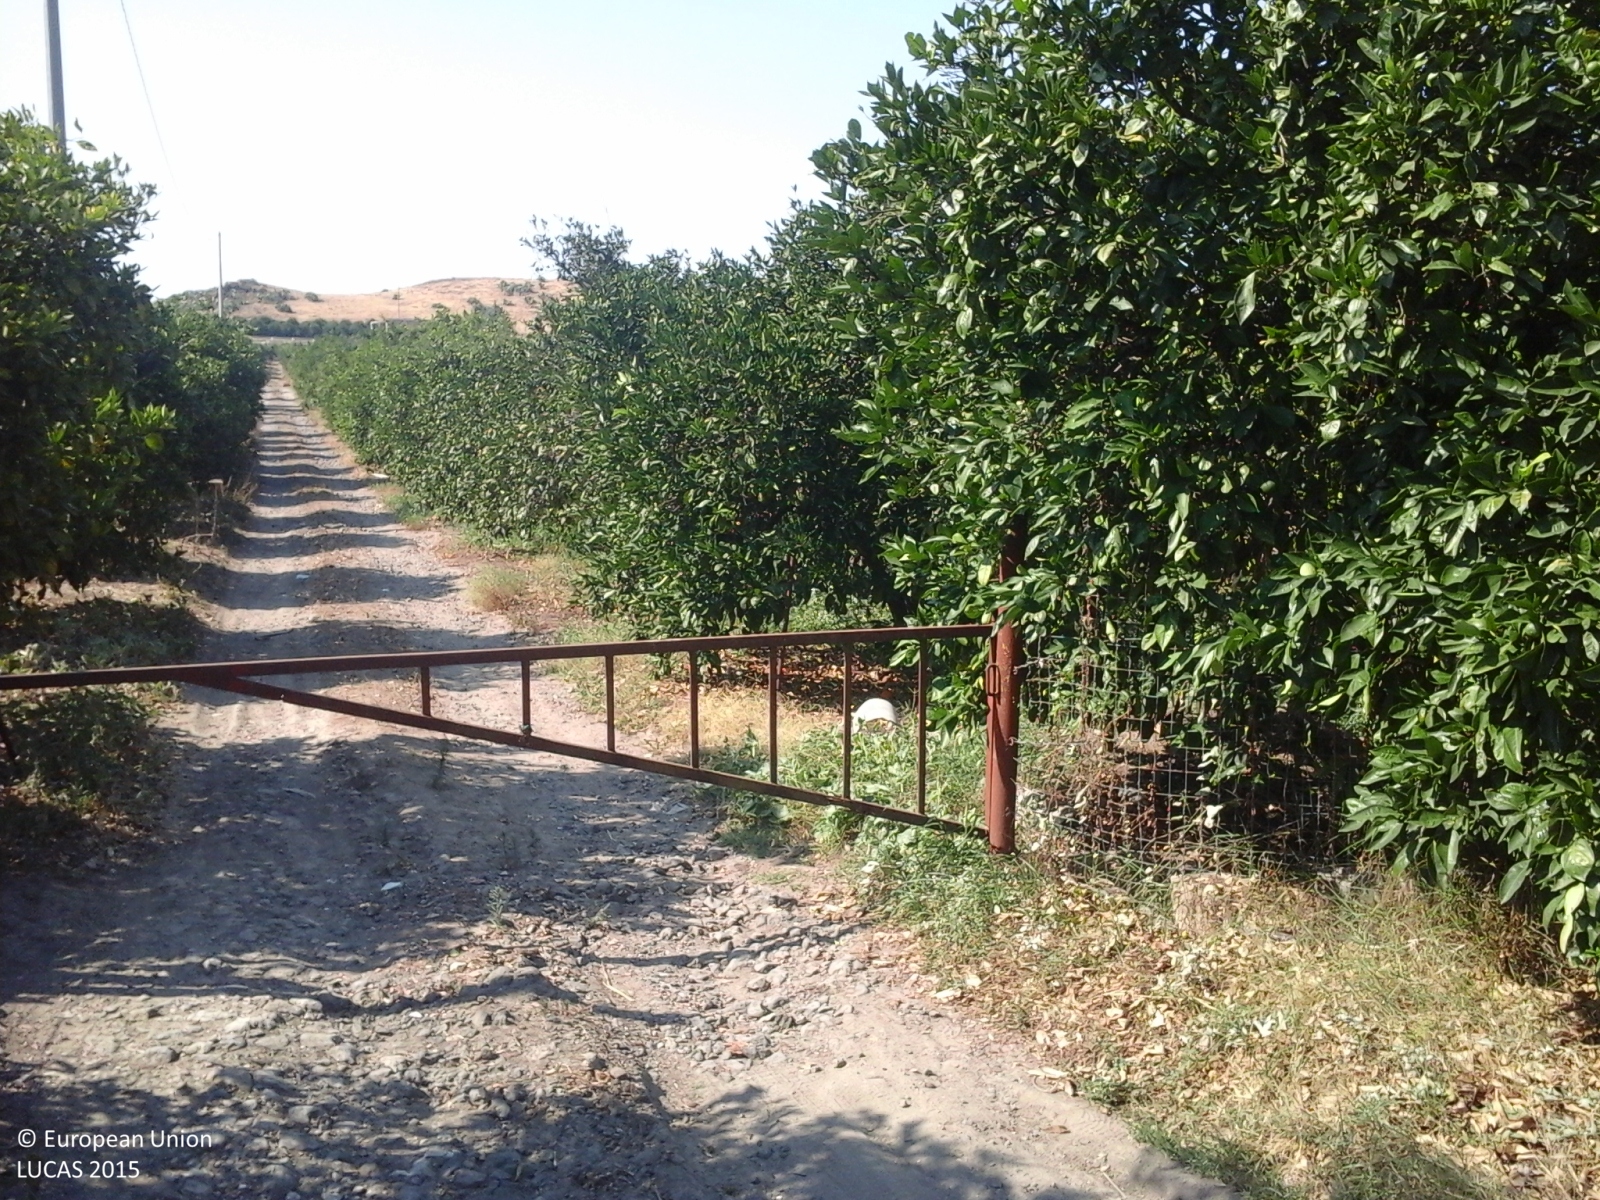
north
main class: Cropland
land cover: Oranges
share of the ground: > 75 %
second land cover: Spontaneously vegetated surfaces
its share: > 75 %
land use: Agriculture (excluding fallow land and kitchen gardens)
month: July
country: IT
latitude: 37.3713
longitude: 14.8087
